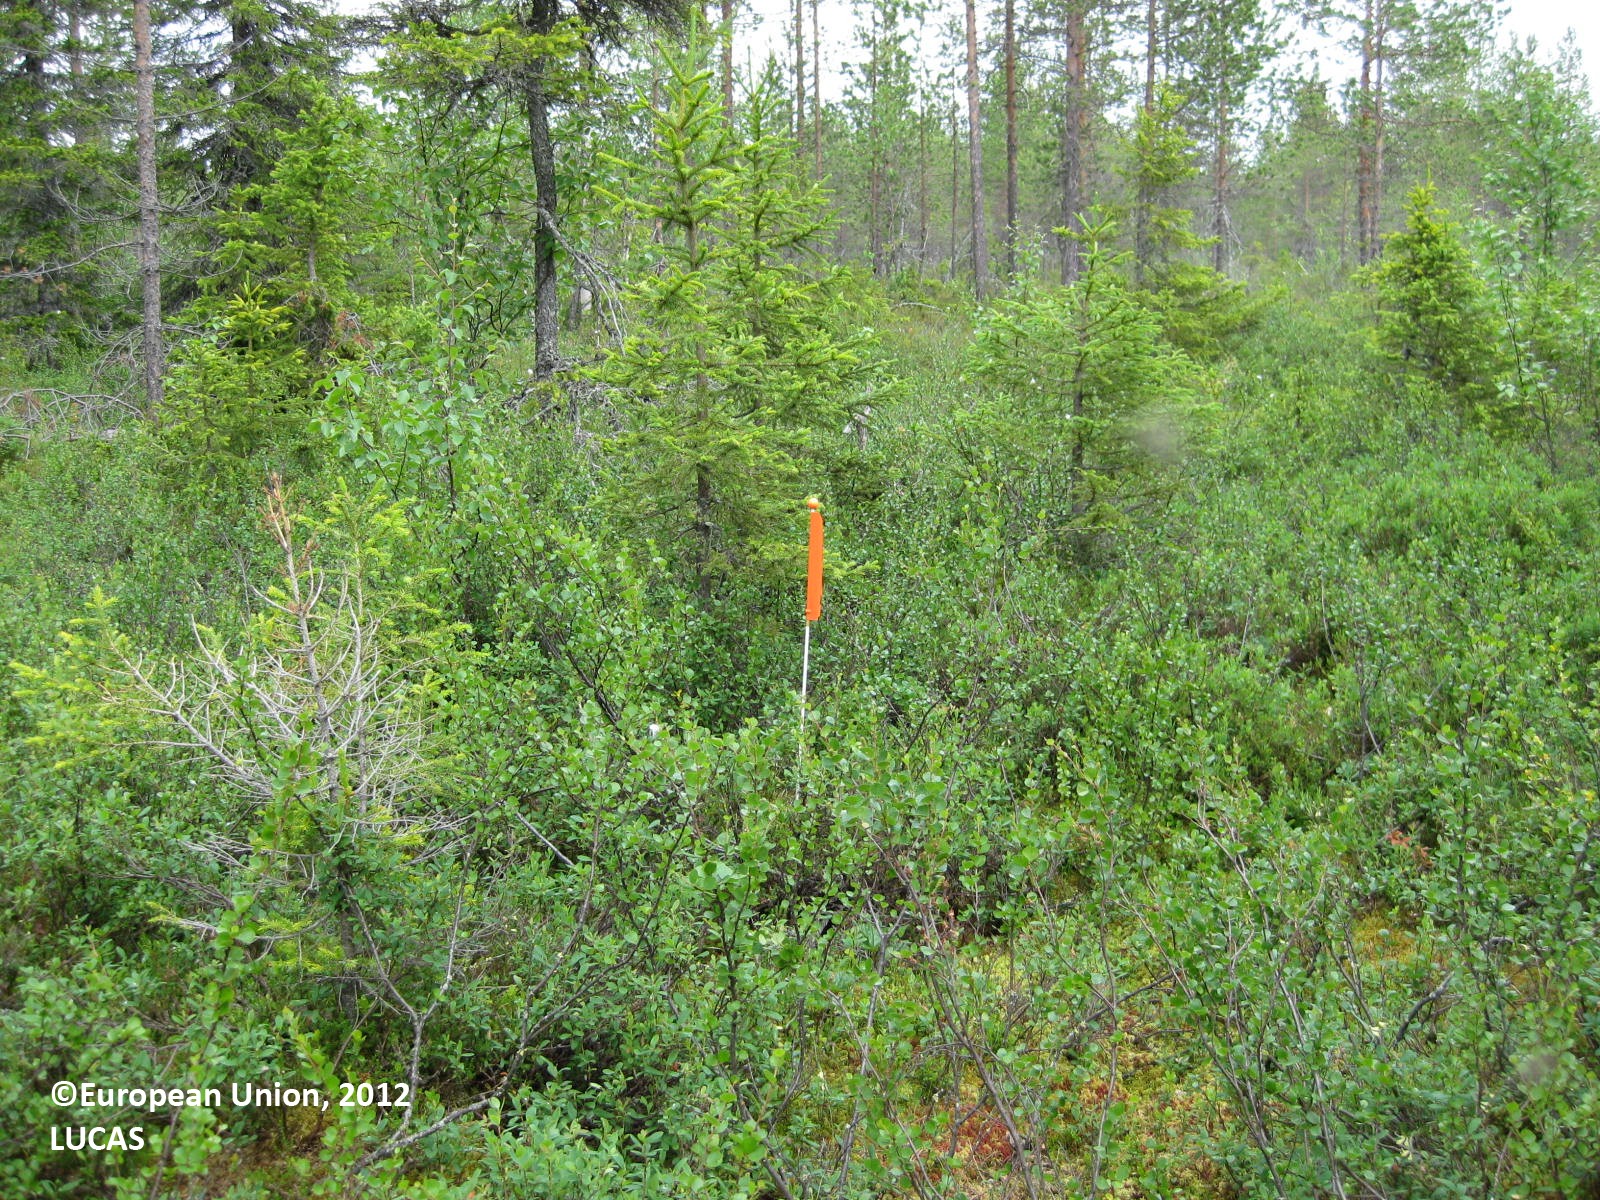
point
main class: Woodland
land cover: Other mixed woodland
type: boreal forest
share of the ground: 25 - 50 %
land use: Forestry
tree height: > 5 m
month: July
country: FI
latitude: 65.4216
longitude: 28.3651
